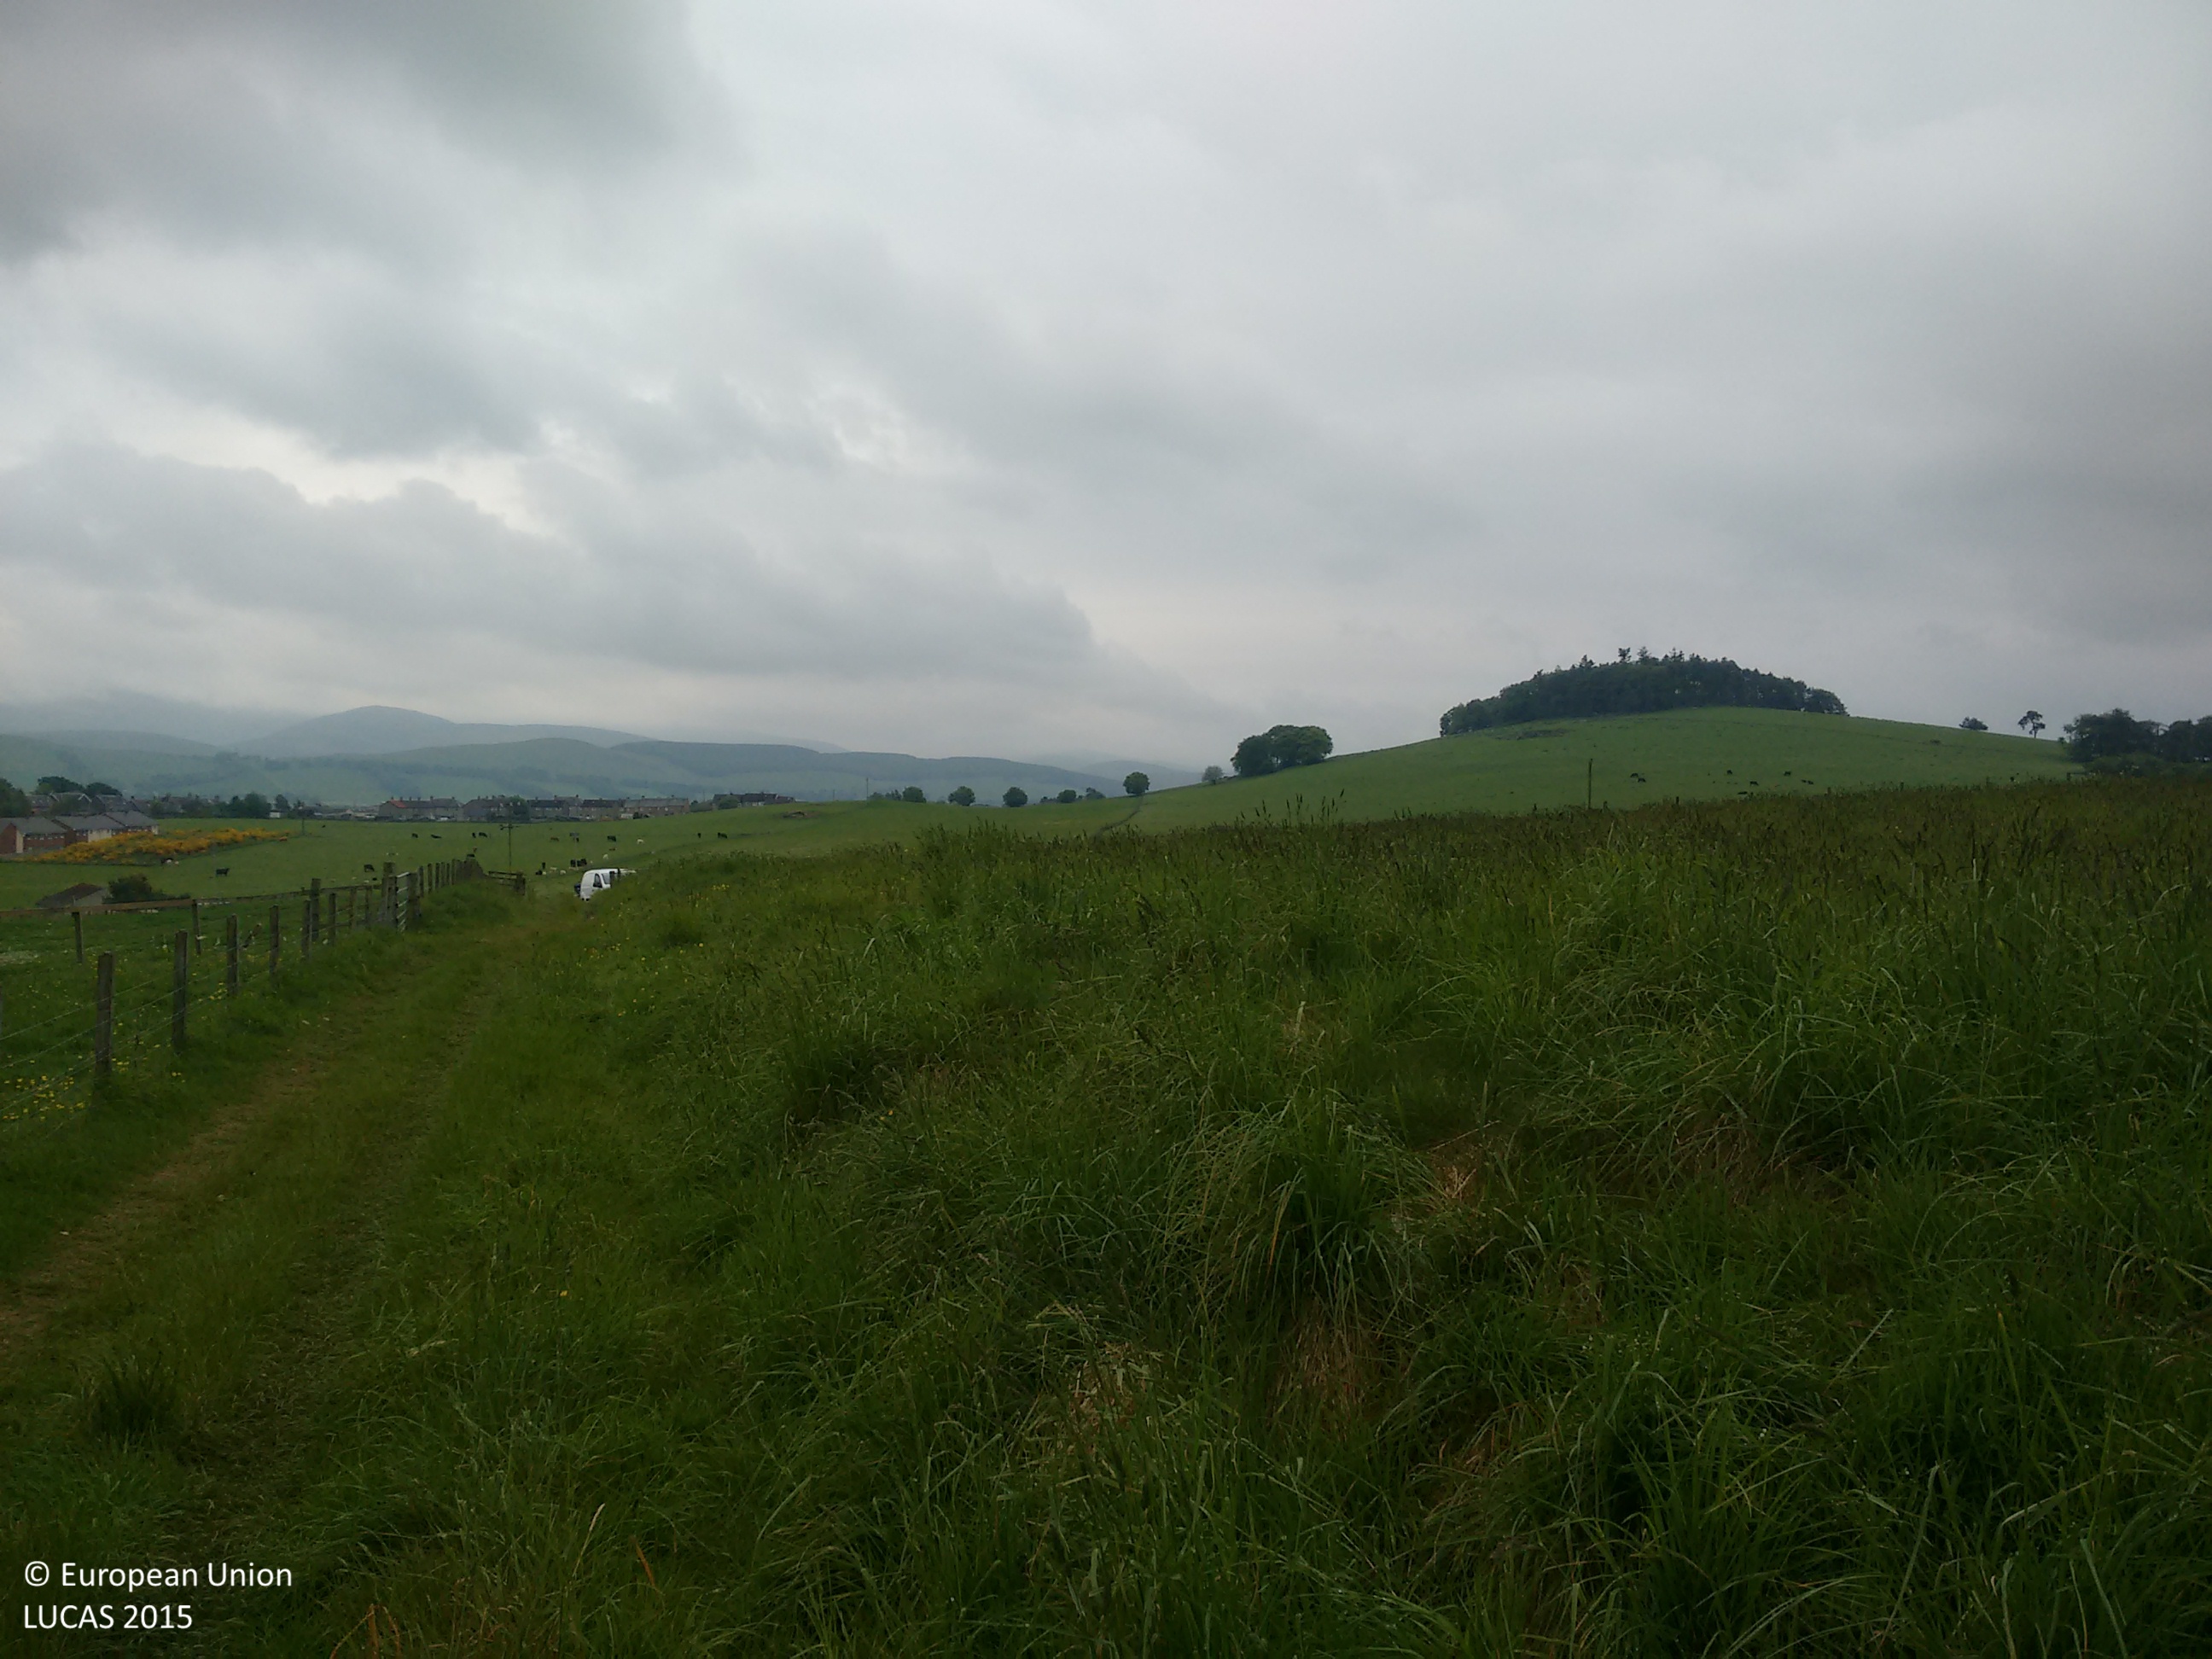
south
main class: Grassland
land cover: Grassland without tree/shrub cover
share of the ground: > 75 %
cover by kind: herbaceous plants 100 %
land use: Agriculture (excluding fallow land and kitchen gardens)
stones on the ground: < 10 %
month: June
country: GB
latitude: 55.6308
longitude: -3.5325
